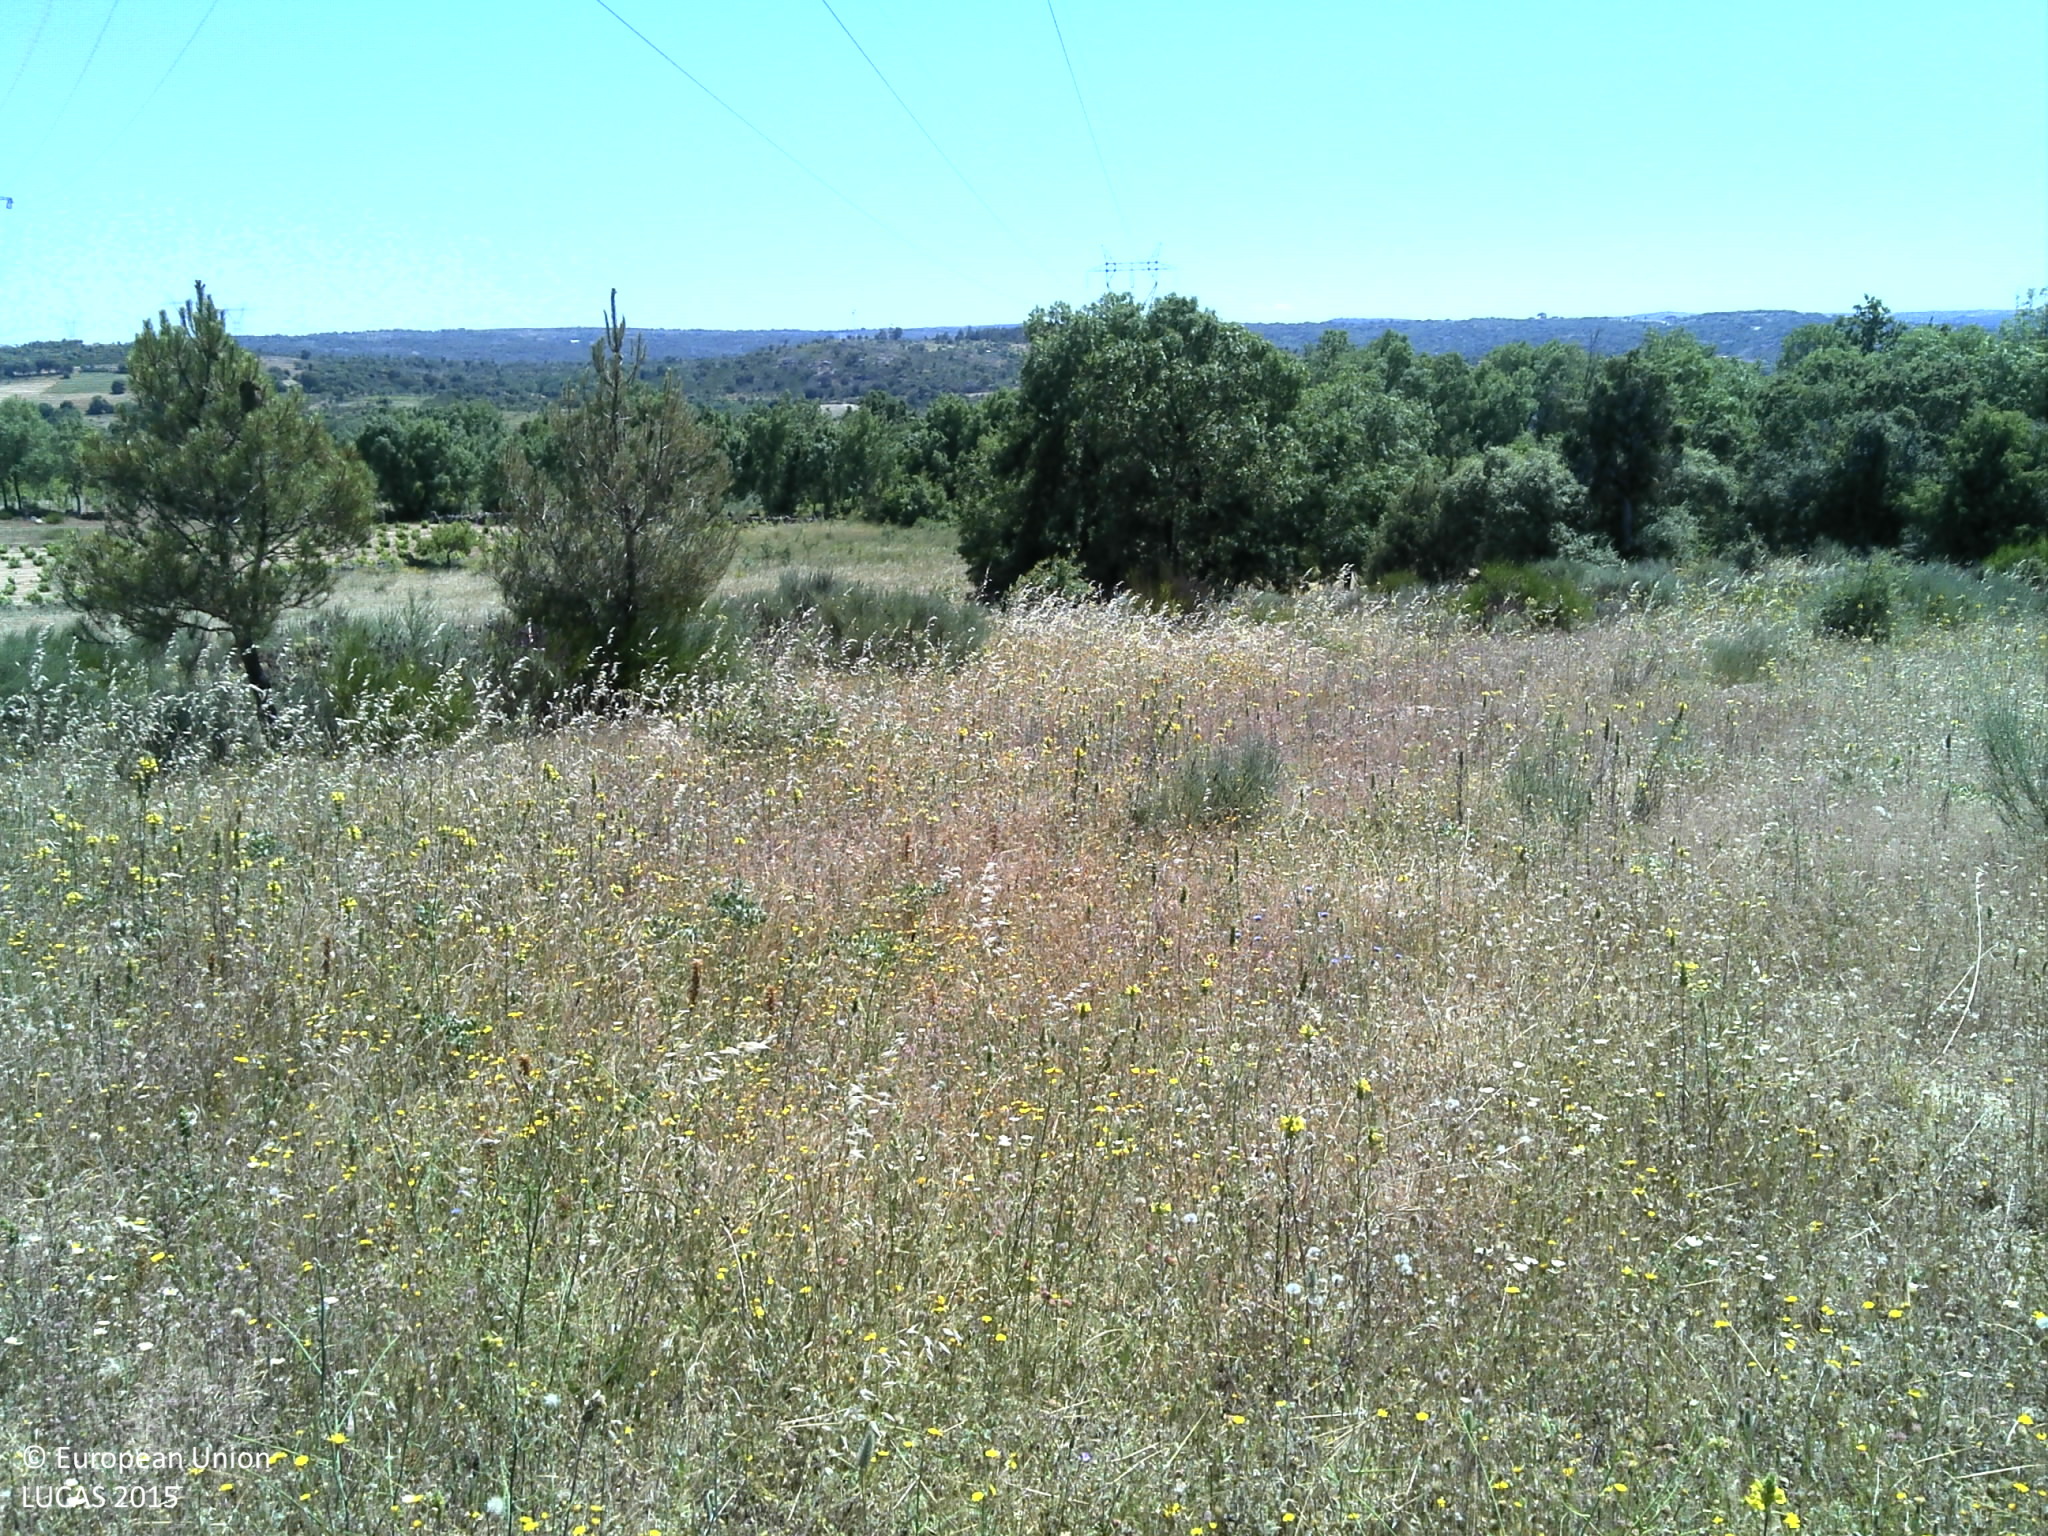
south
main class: Artificial land
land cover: Other artificial areas
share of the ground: 25 - 50 %
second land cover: Grassland without tree/shrub cover
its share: 50 - 75 %
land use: Electricity, gas and thermal power distribution
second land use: Agriculture (excluding fallow land and kitchen gardens)
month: May
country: PT
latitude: 41.4061
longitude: -6.3547
